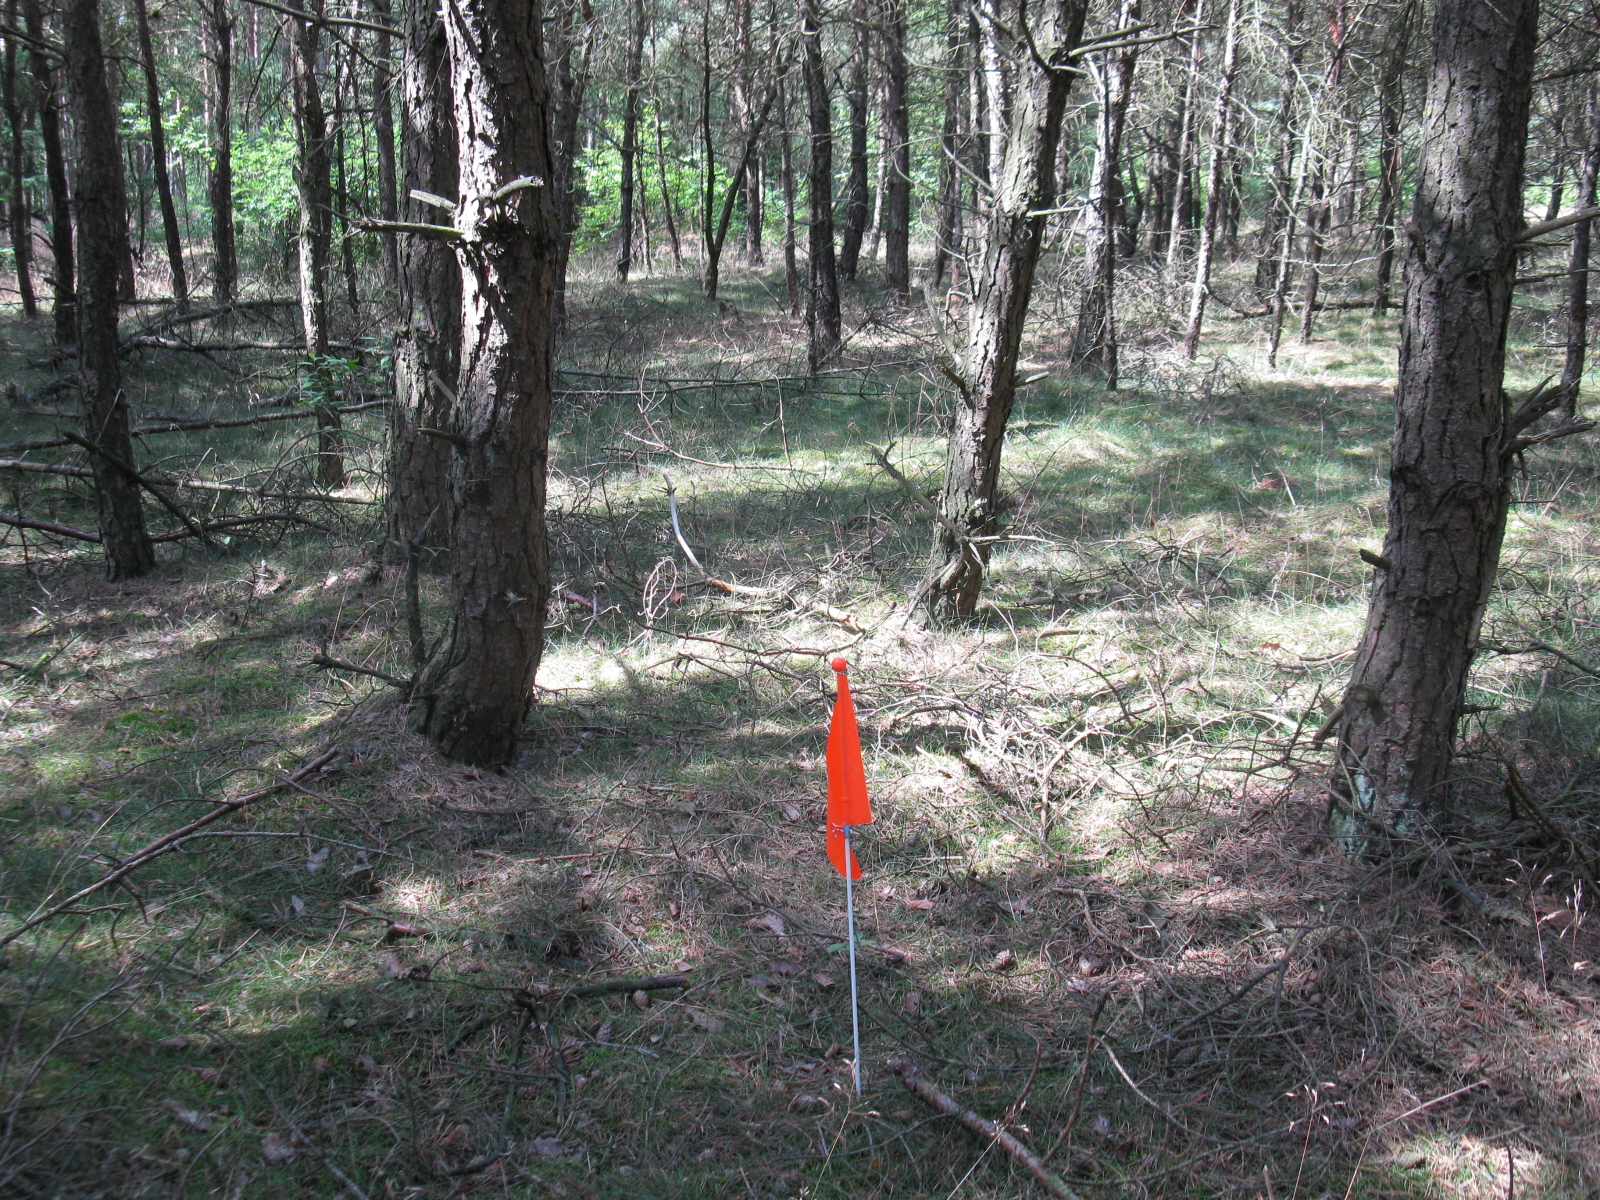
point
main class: Woodland
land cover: Pine dominated coniferous woodland
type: hemiboreal forest and nemoral coniferous forest and mixed broadleaved-coniferous forest
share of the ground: > 75 %
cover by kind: coniferous forest trees 100 %
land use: Forestry
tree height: > 5 m
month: July
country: DE
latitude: 52.9053
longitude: 8.3502
